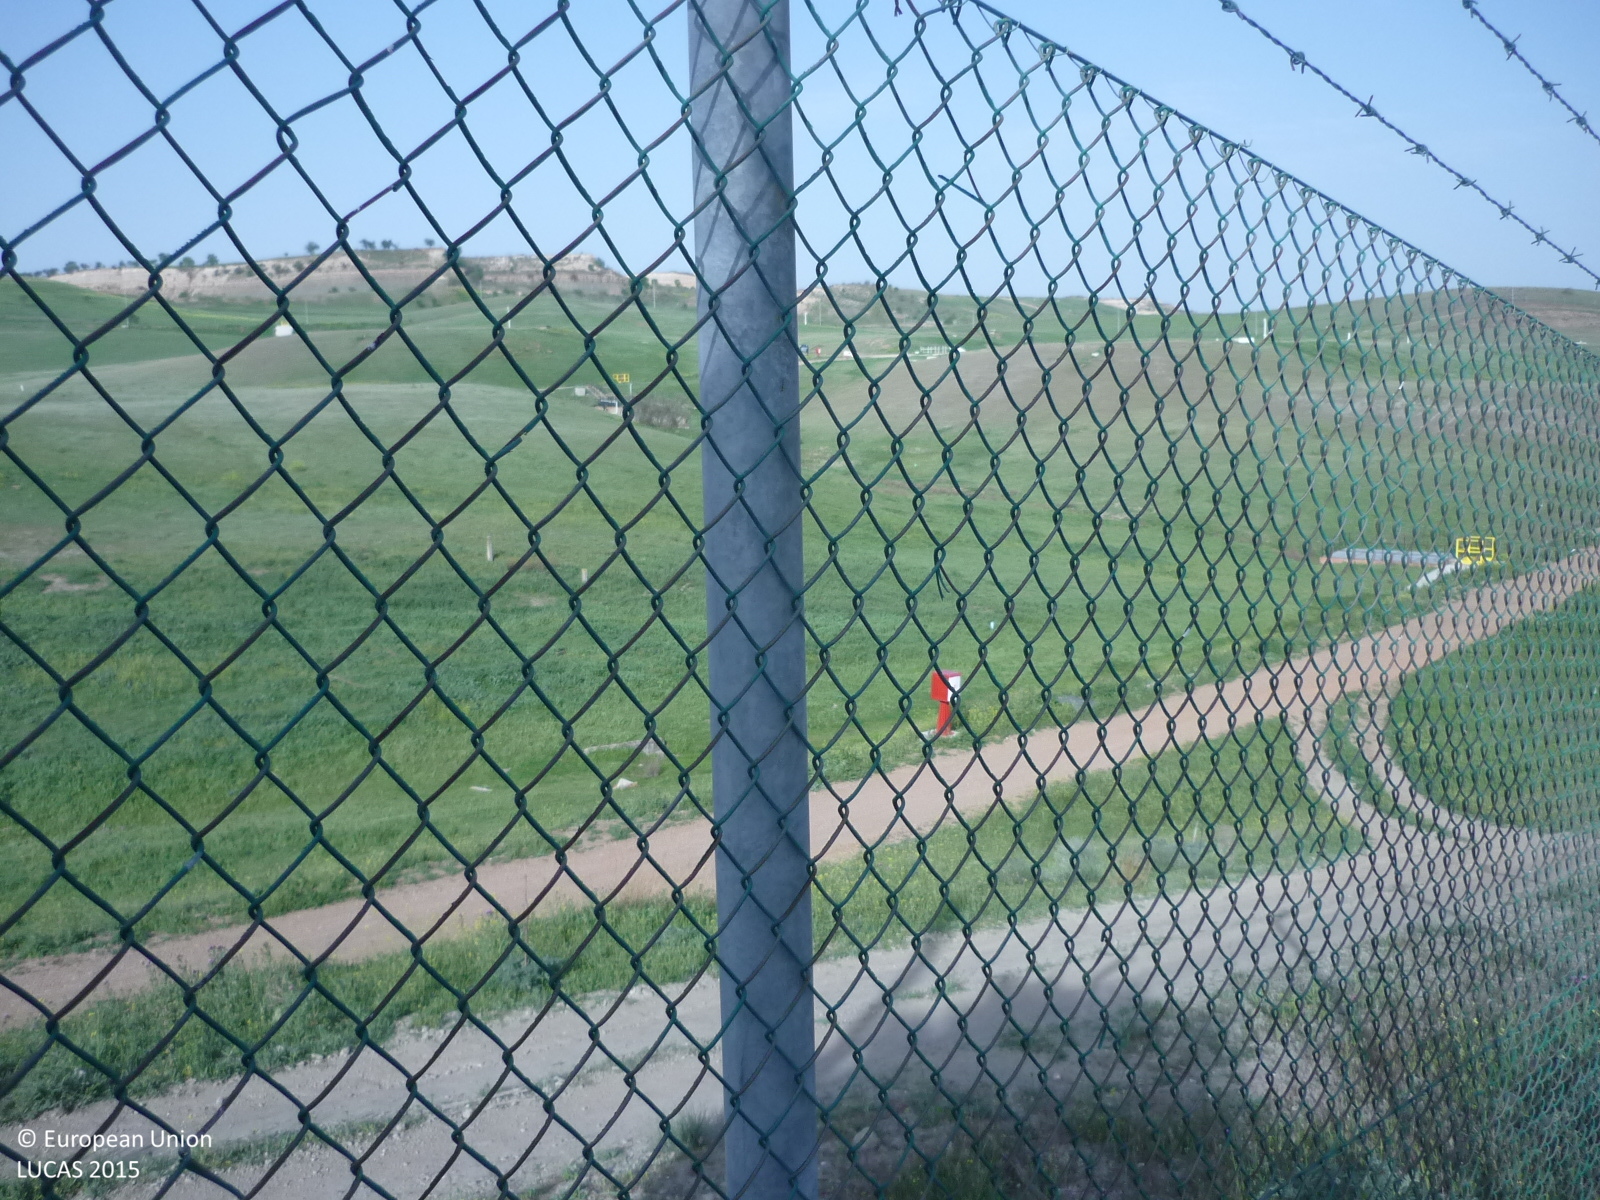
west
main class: Grassland
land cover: Grassland without tree/shrub cover
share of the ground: > 75 %
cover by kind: herbaceous plants 90 %, unconsolidated bare surface 10 %
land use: Electricity, gas and thermal power distribution
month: April
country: ES
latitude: 40.4190
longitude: -3.4343
